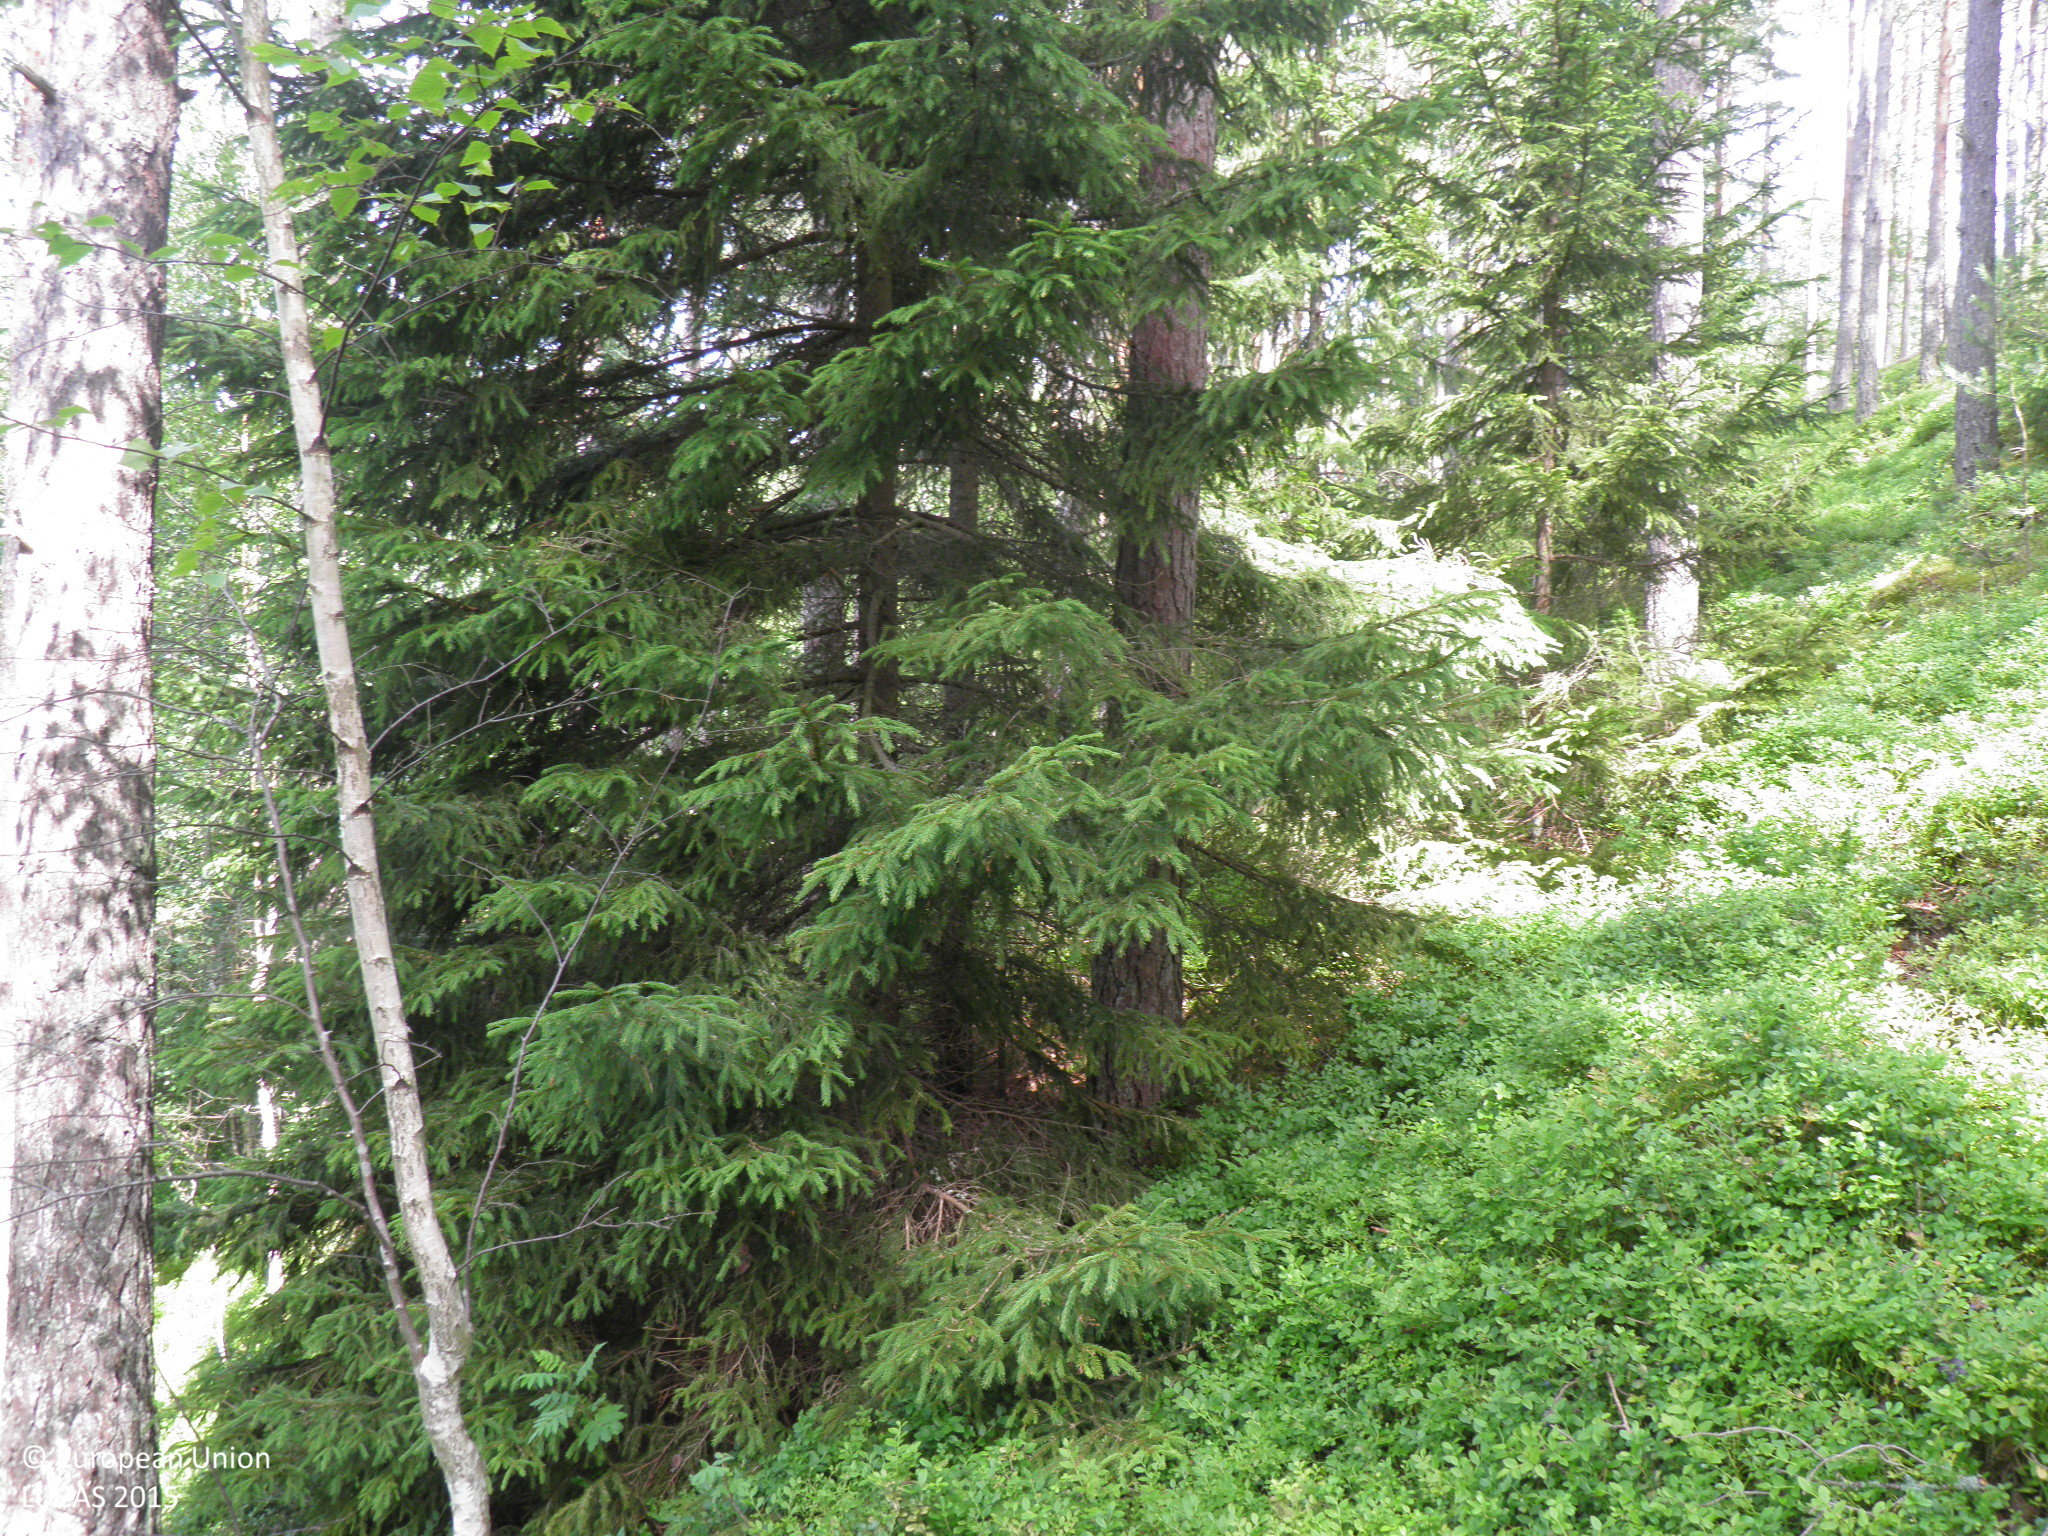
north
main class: Woodland
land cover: Pine dominated coniferous woodland
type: hemiboreal forest and nemoral coniferous forest and mixed broadleaved-coniferous forest
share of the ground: > 75 %
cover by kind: coniferous forest trees 70 %, shrubs 20 %, broadleaved forest trees 10 %
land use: Forestry
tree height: > 5 m
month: July
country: FI
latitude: 60.0500
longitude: 22.4083
